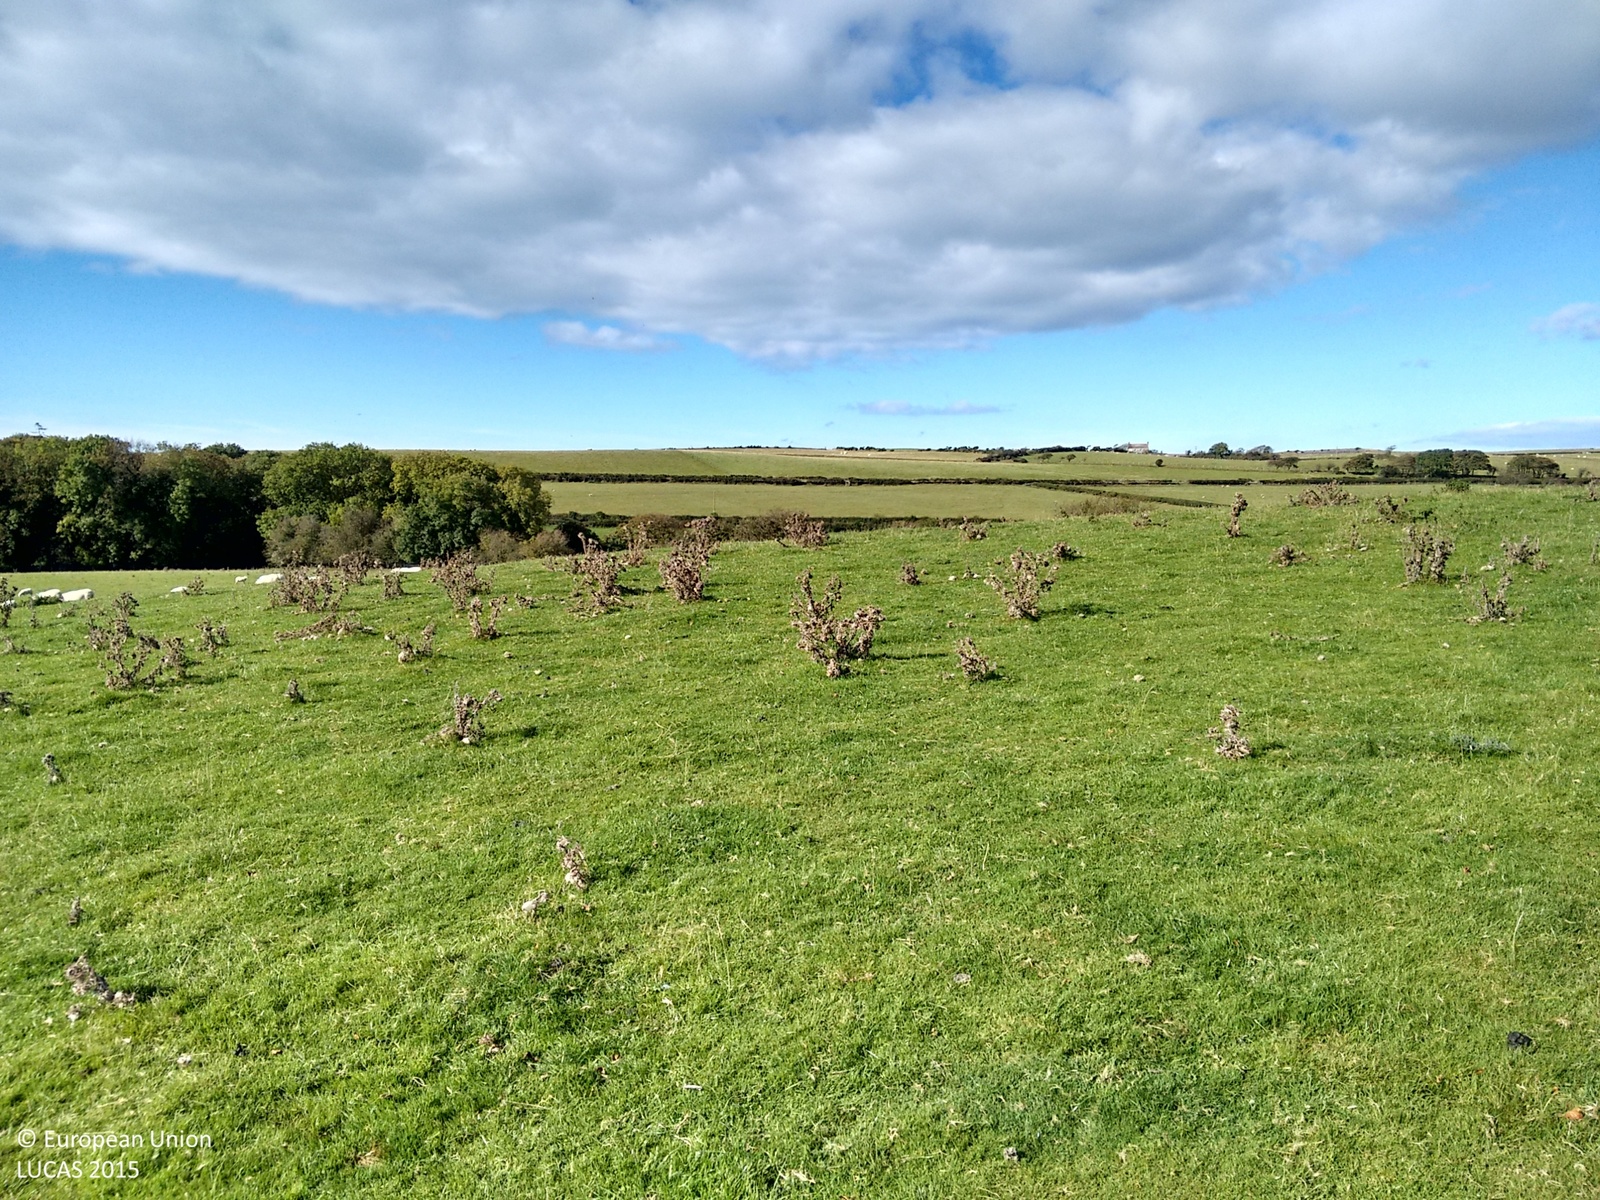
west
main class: Grassland
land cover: Grassland without tree/shrub cover
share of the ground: > 75 %
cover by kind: herbaceous plants 100 %
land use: Agriculture (excluding fallow land and kitchen gardens)
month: October
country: GB
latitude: 52.3324
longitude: -4.1115
